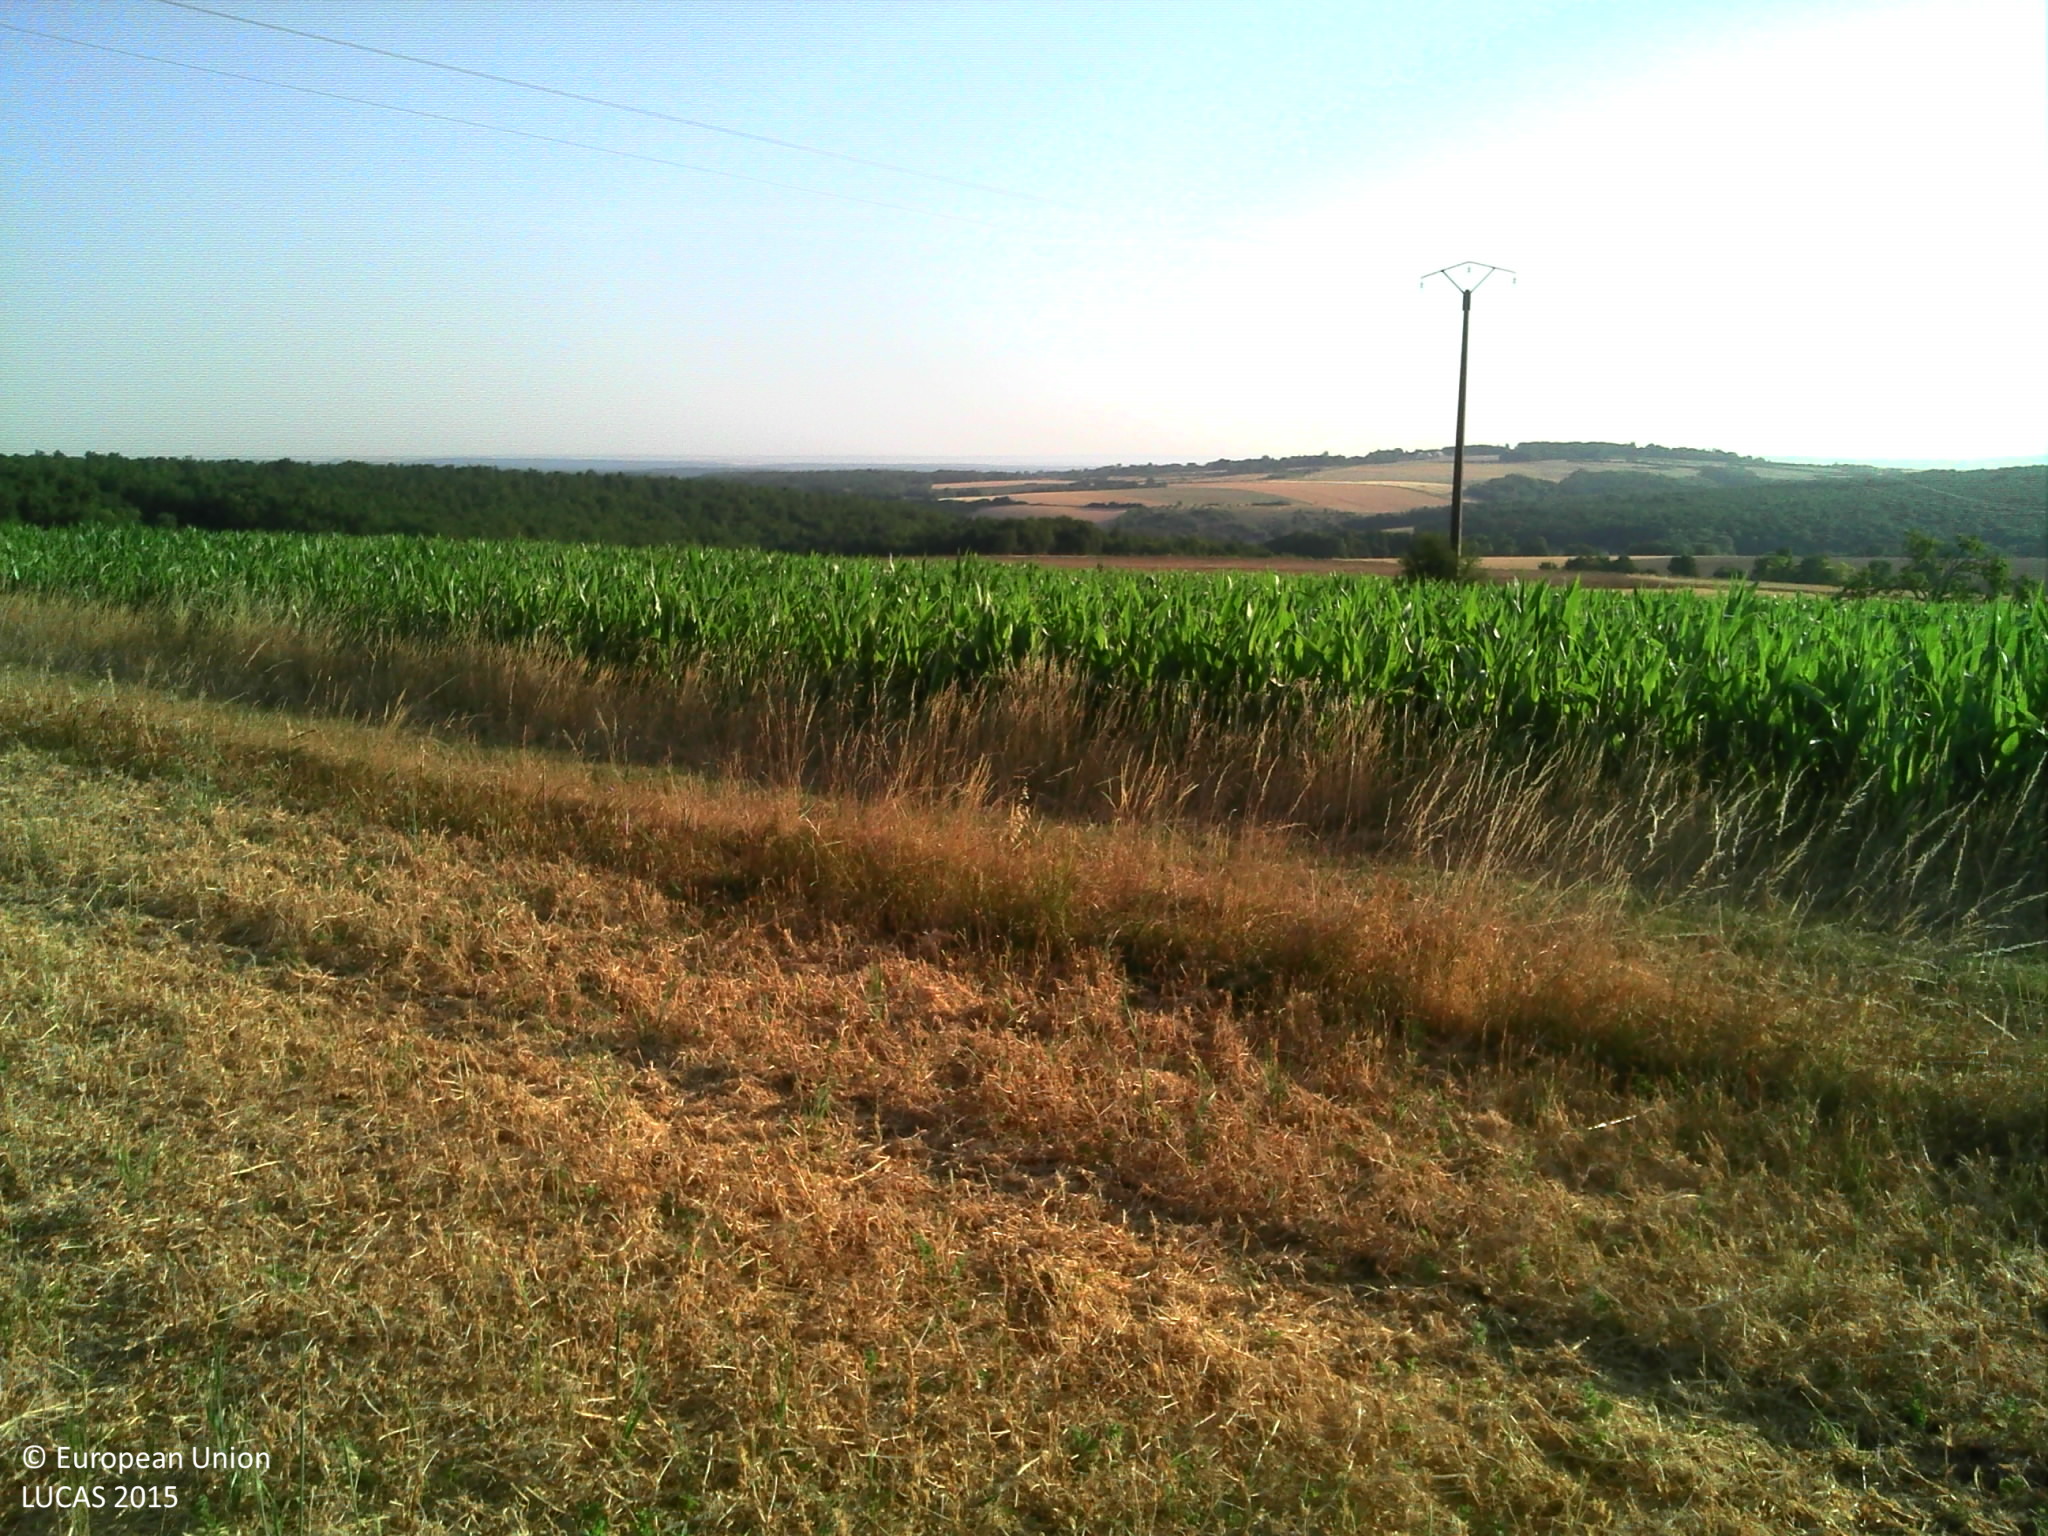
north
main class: Cropland
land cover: Dry pulses
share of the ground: > 75 %
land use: Agriculture (excluding fallow land and kitchen gardens)
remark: Harvested field
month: July
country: FR
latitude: 47.7054
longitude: 3.4786
